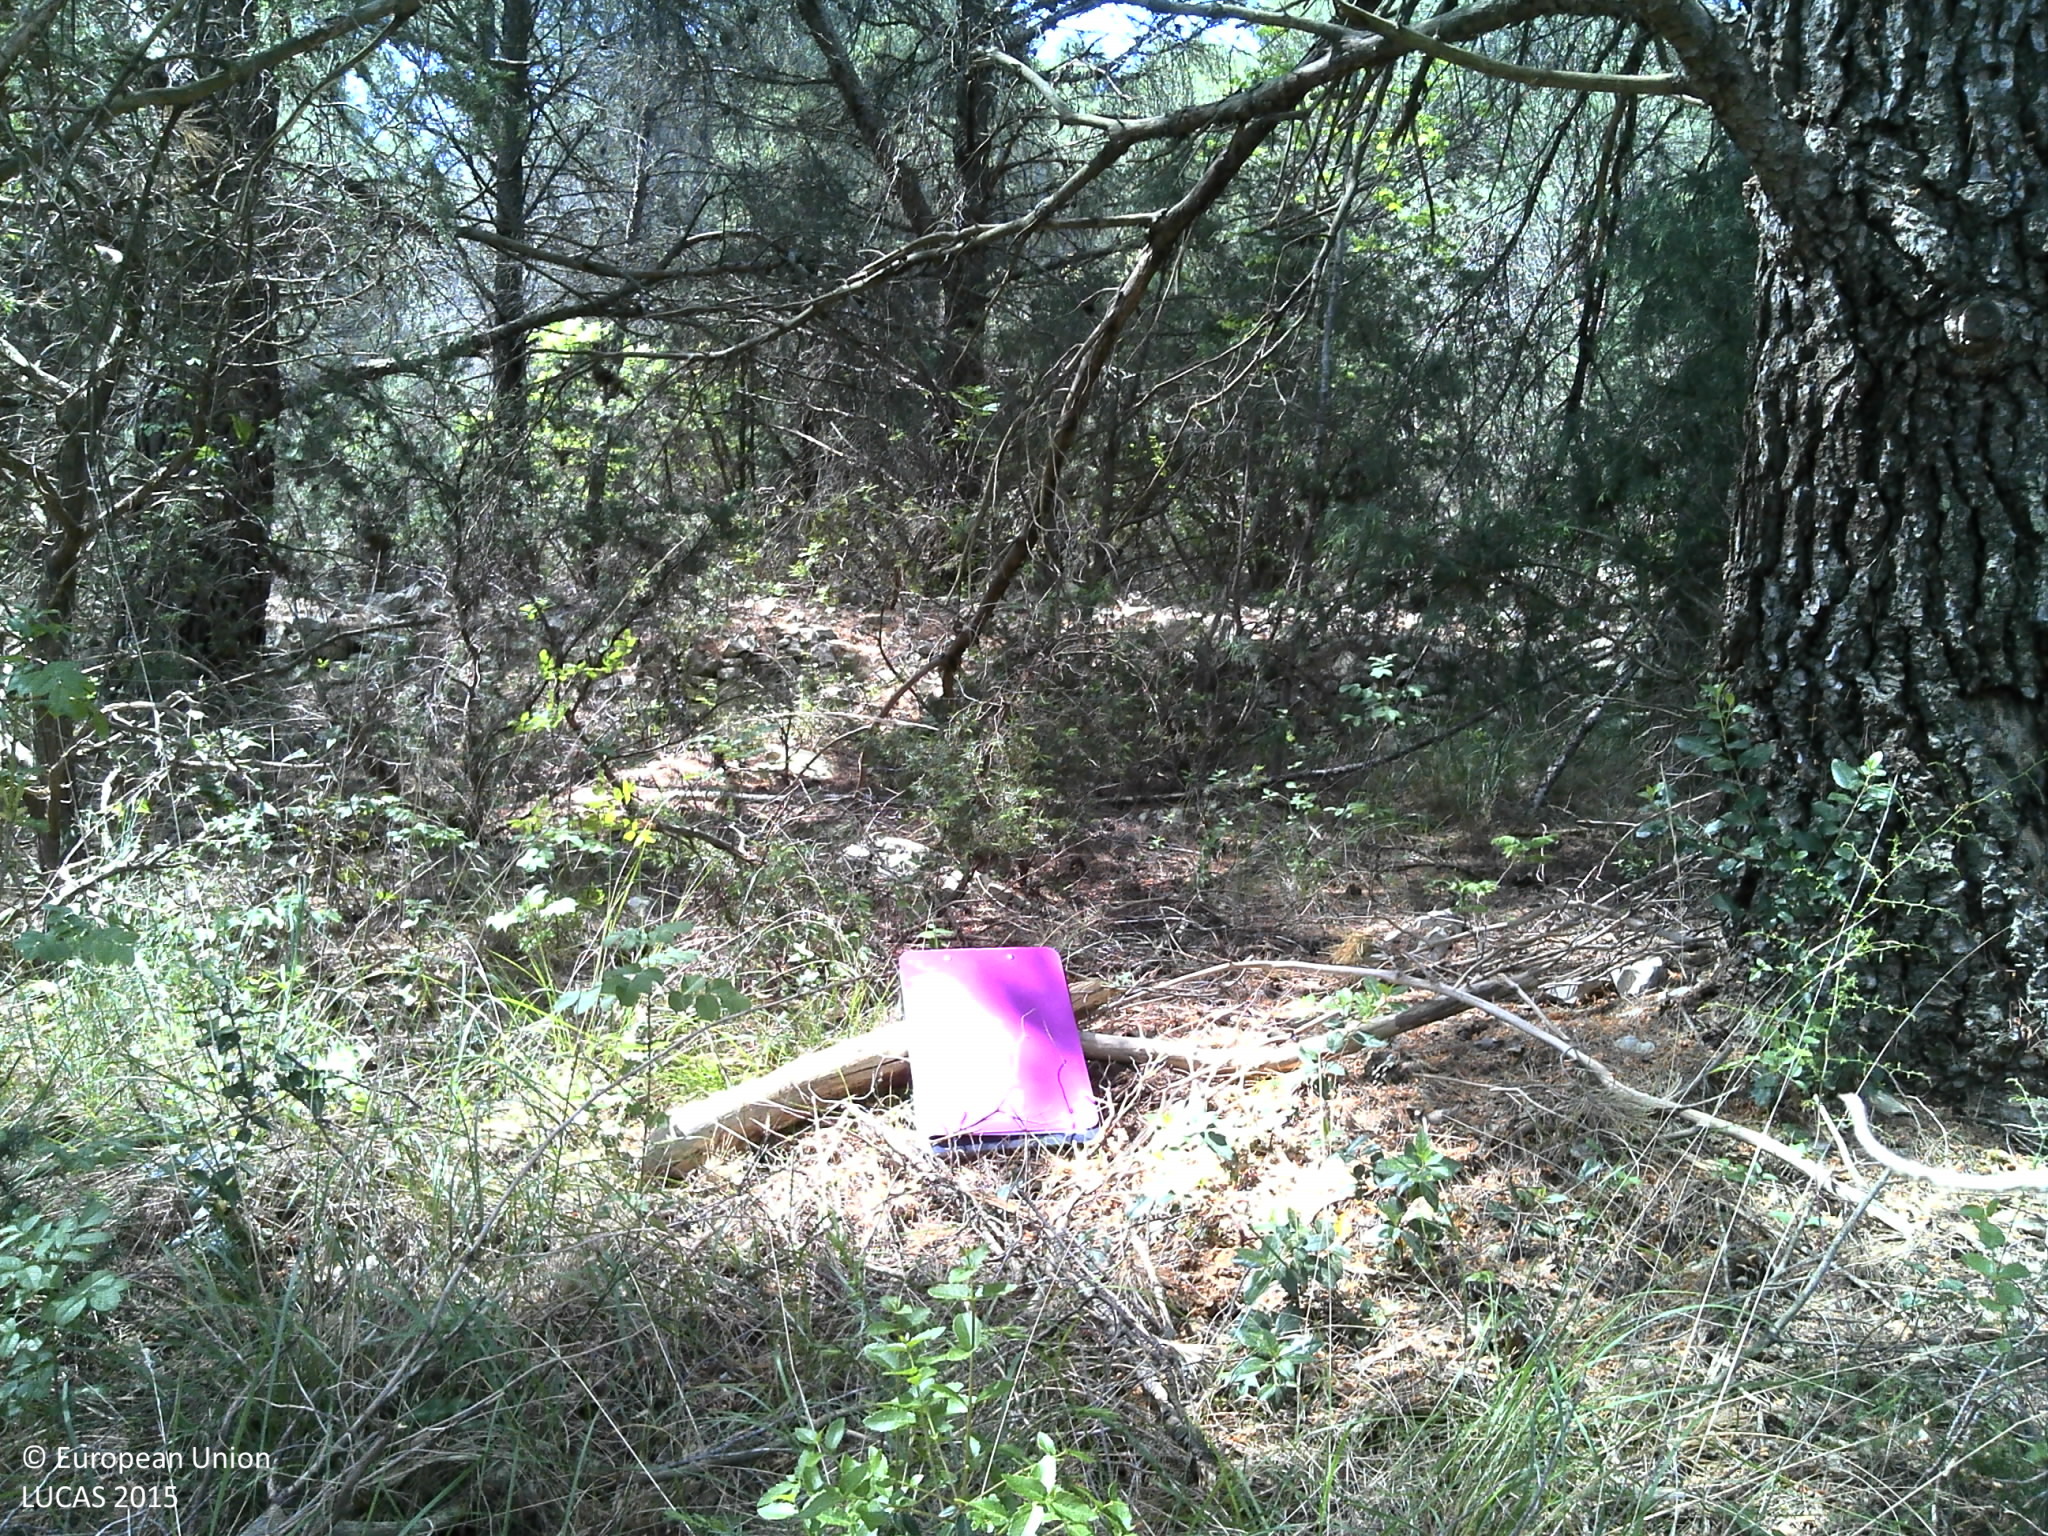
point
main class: Woodland
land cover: Pine dominated coniferous woodland
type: coniferous forest of the mediterranean region
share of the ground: > 75 %
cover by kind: coniferous forest trees 85 %, shrubs 5 %, lichens and mosses 5 %, unconsolidated bare surface 5 %
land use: Semi-natural and natural areas not in use
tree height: > 5 m
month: April
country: HR
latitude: 43.7658
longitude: 15.9165
